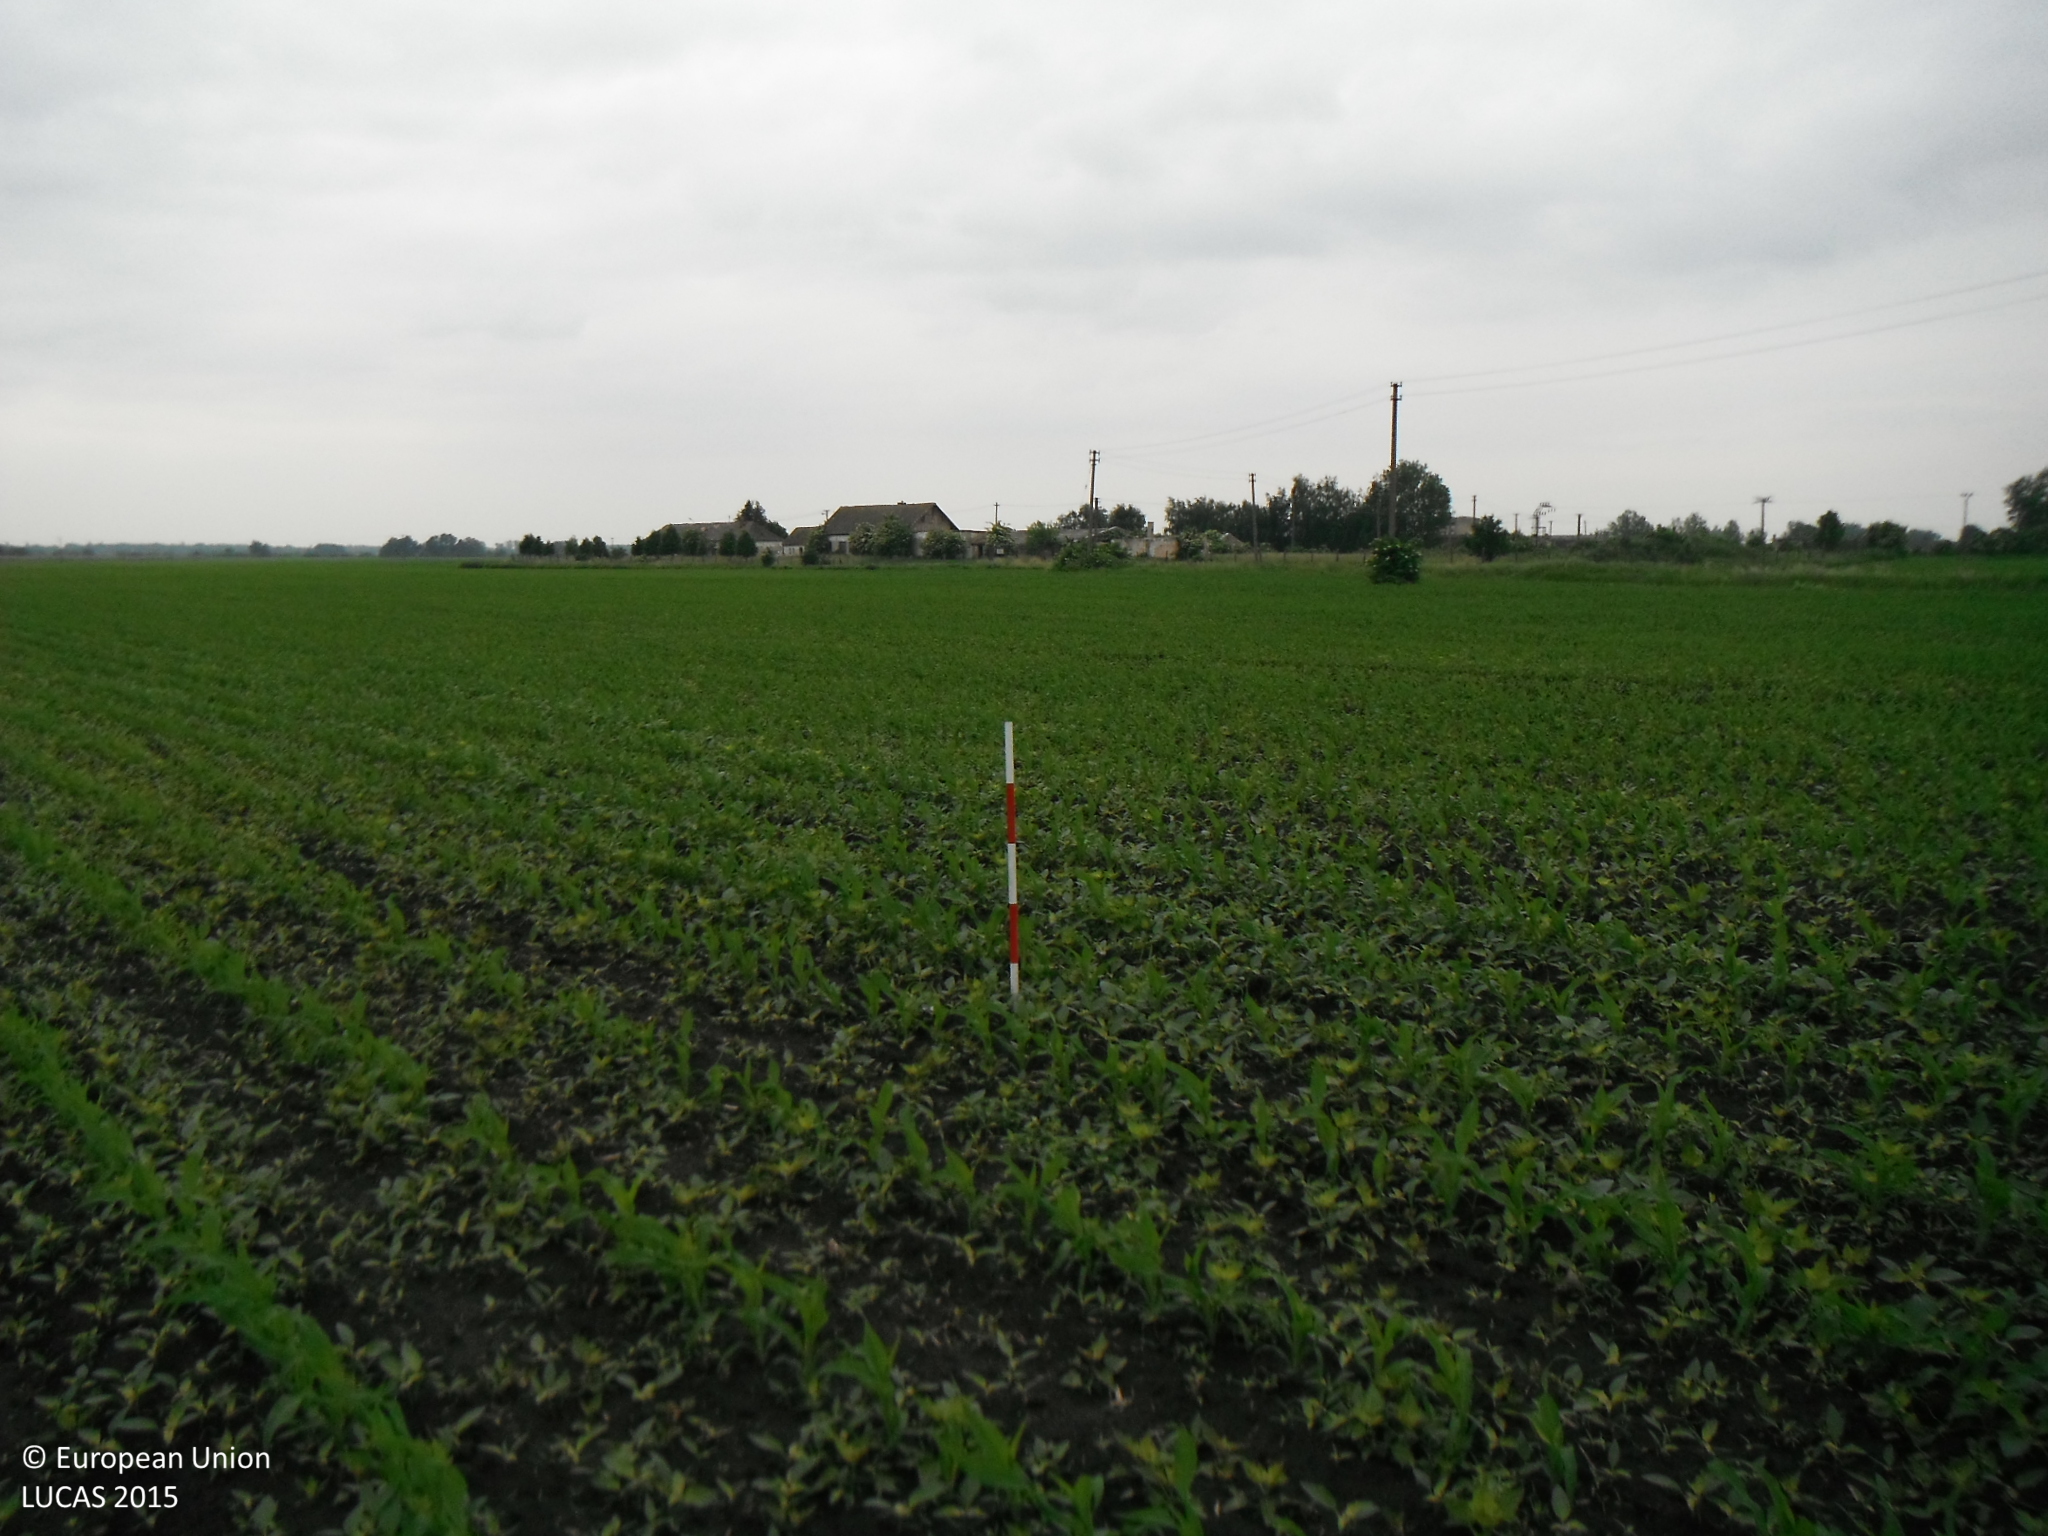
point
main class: Cropland
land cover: Maize
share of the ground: 25 - 50 %
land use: Agriculture (excluding fallow land and kitchen gardens)
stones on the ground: < 10 %
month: May
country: SK
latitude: 47.9298
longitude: 17.7872
